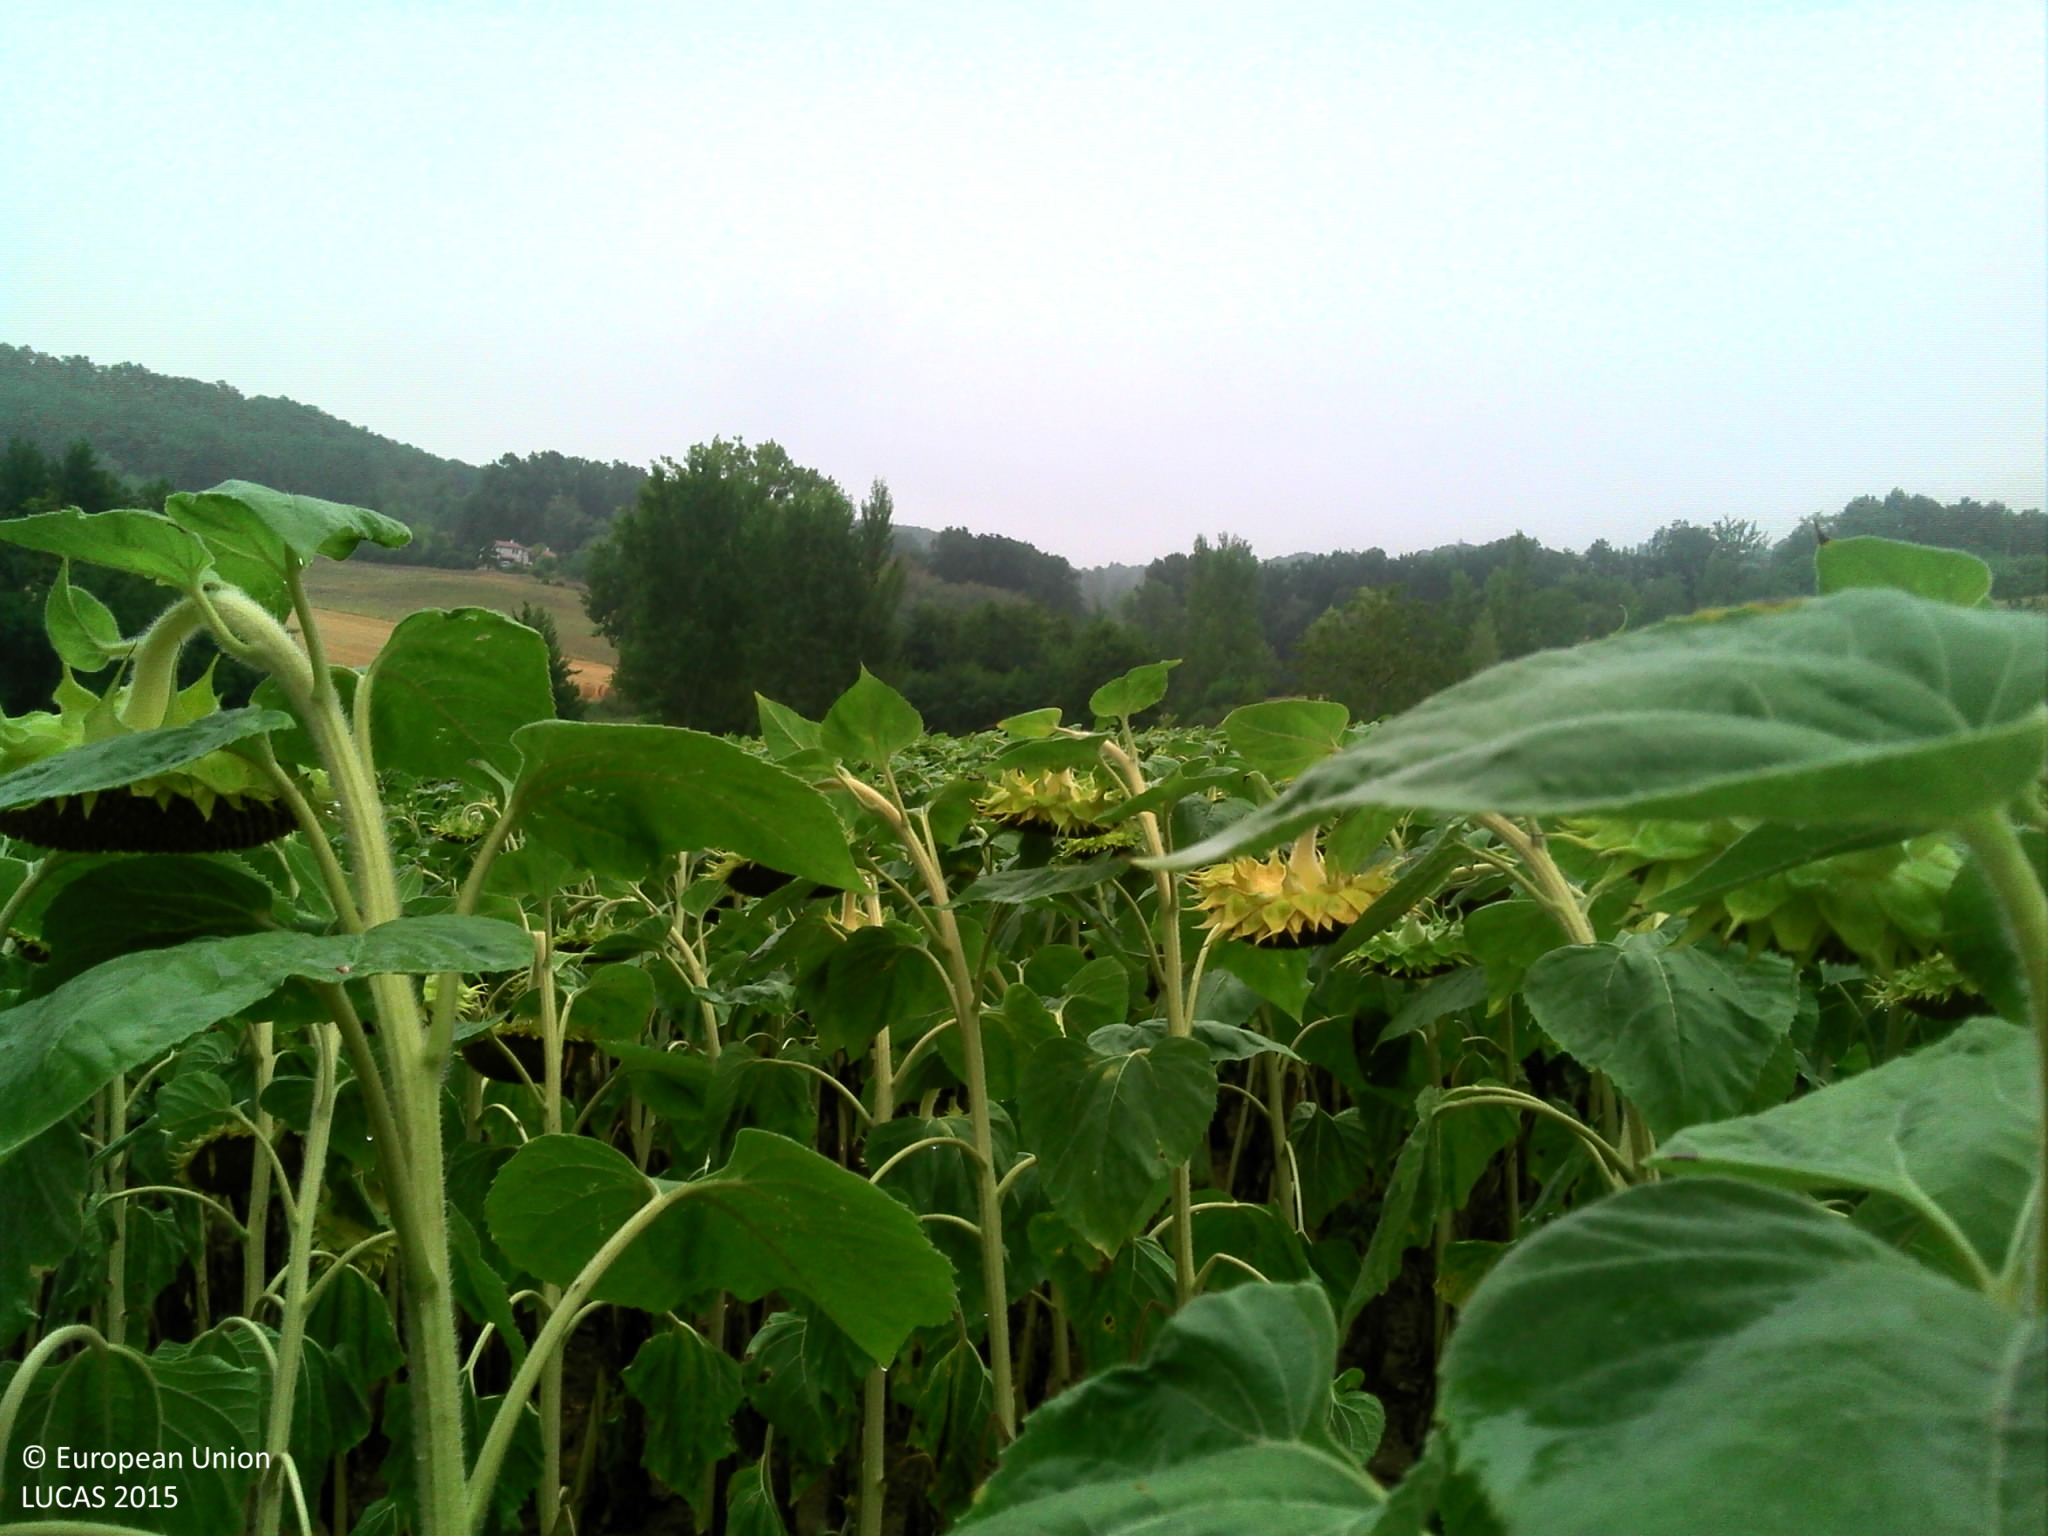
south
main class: Cropland
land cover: Sunflower
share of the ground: > 75 %
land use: Agriculture (excluding fallow land and kitchen gardens)
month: July
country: FR
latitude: 44.3828
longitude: 0.6679
